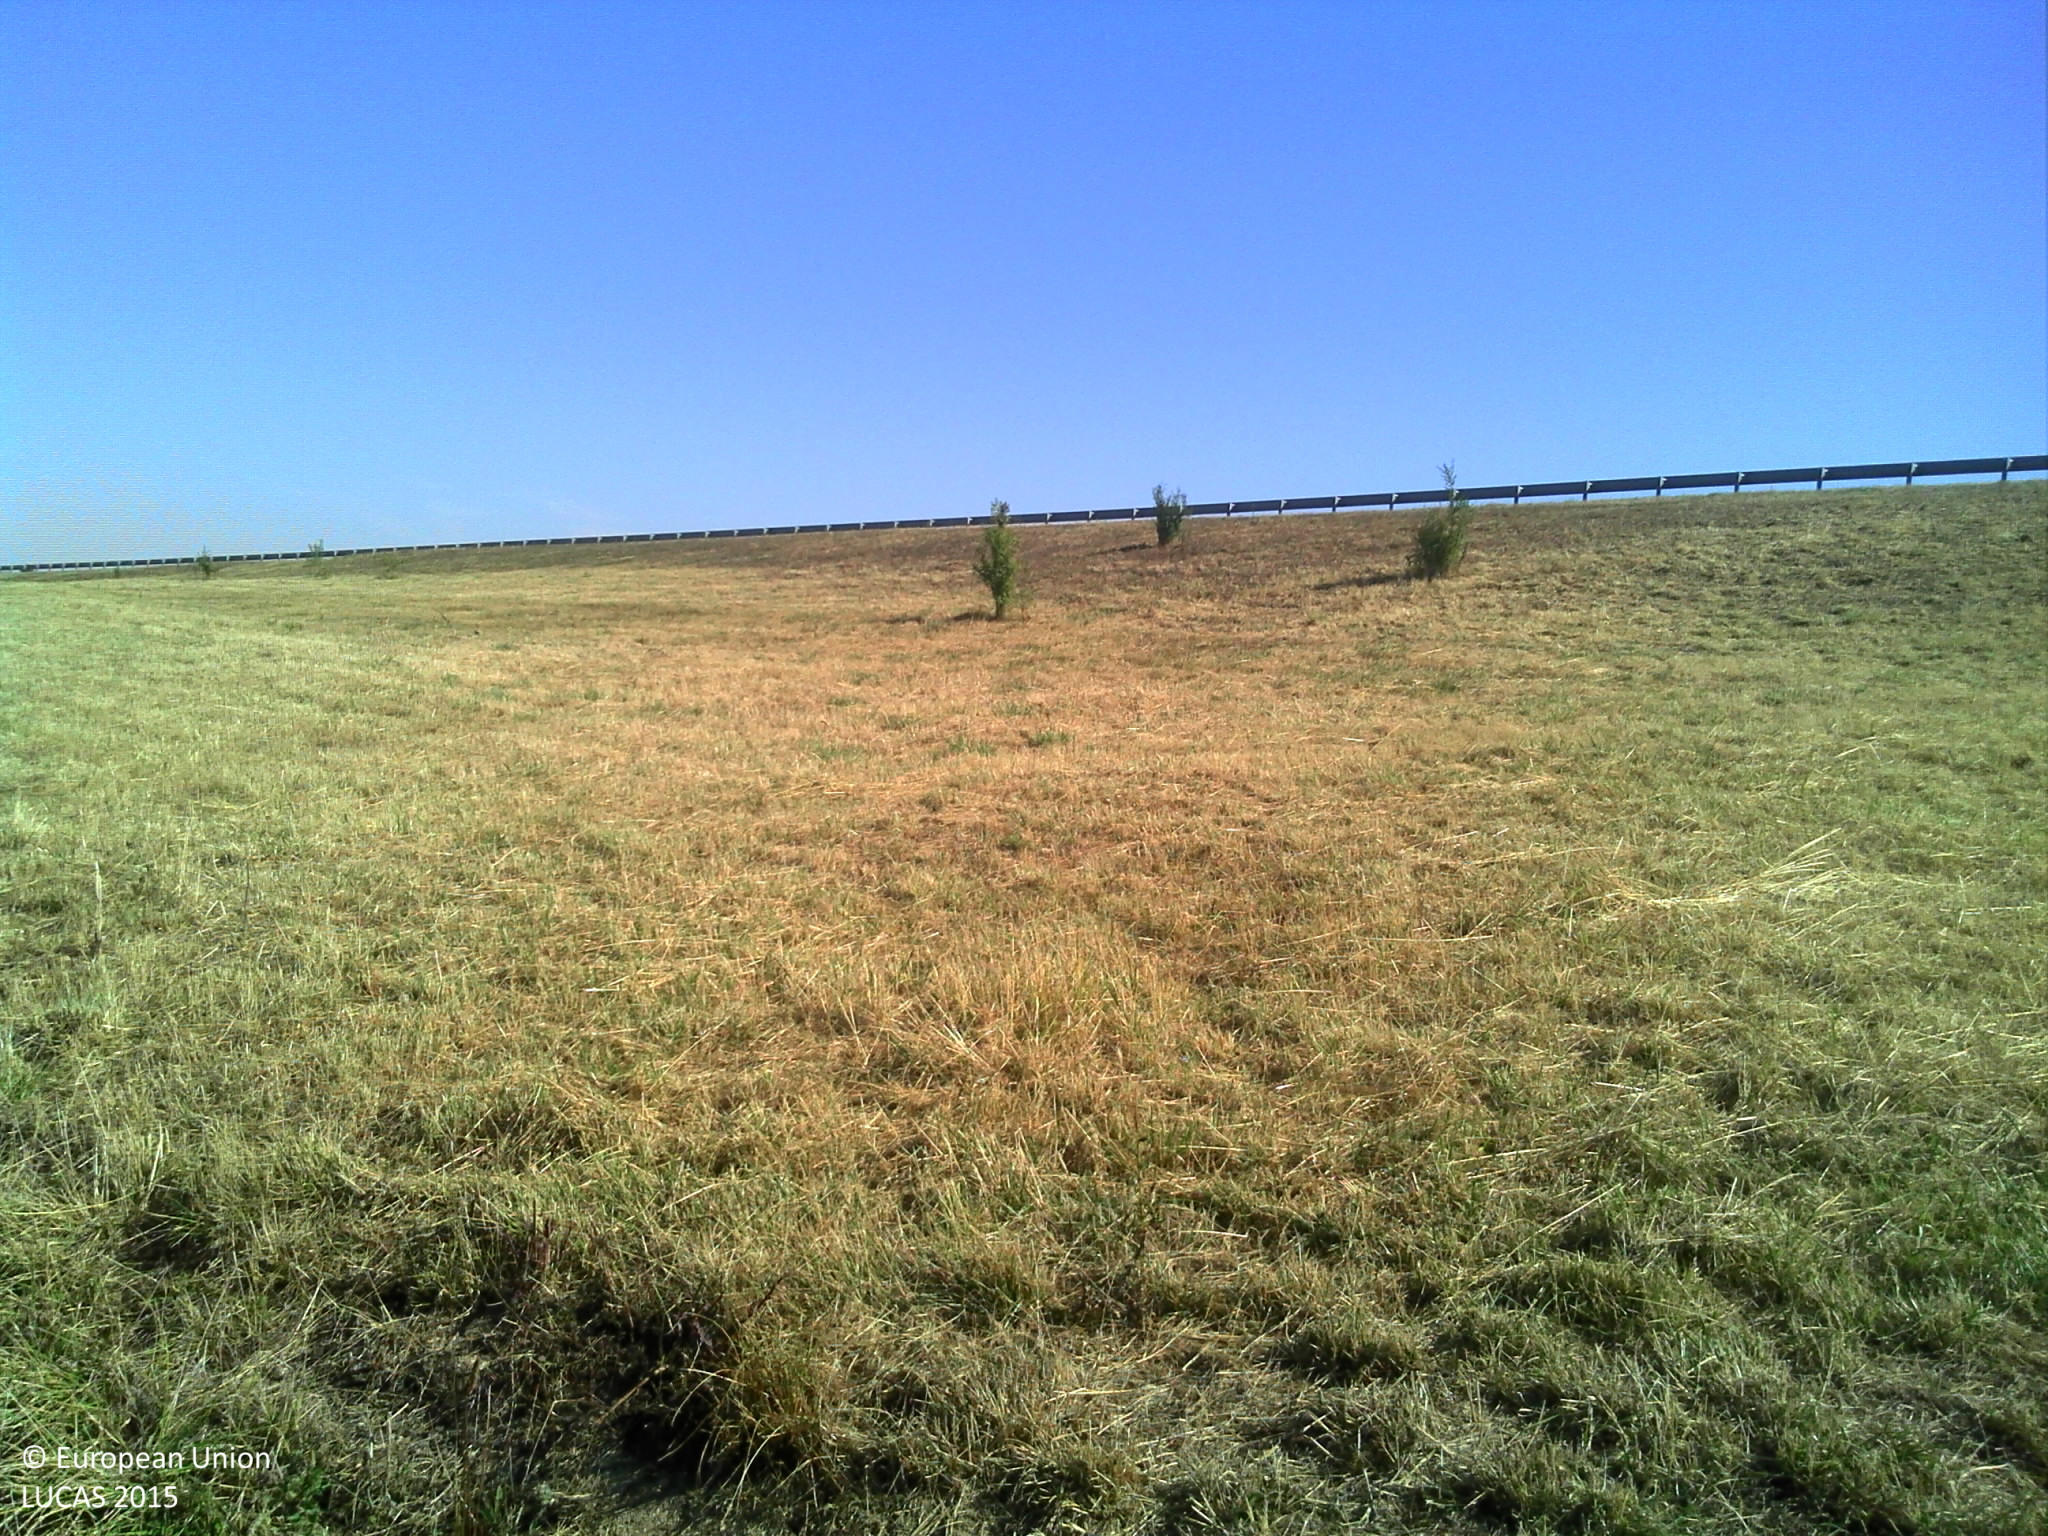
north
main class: Grassland
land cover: Grassland without tree/shrub cover
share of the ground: > 75 %
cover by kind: herbaceous plants 100 %
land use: Road transport
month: August
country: FR
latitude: 48.0971
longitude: 2.0250
